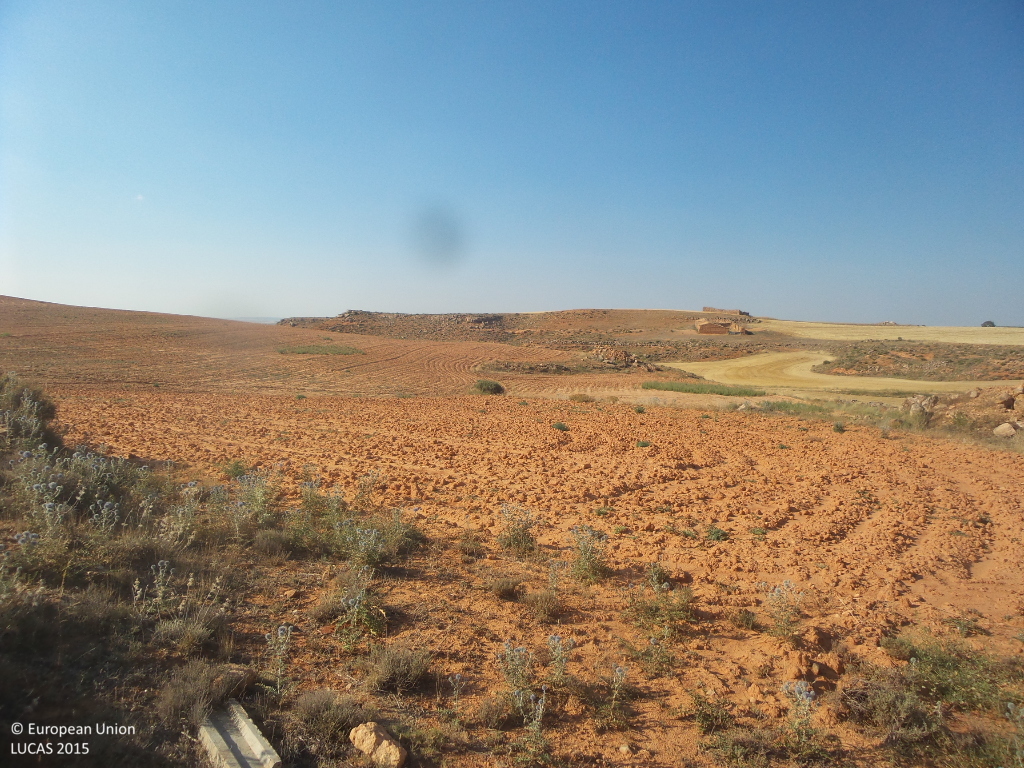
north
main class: Shrubland
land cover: Shrubland without tree cover
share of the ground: 50 - 75 %
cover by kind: shrubs 50 %, unconsolidated bare surface 40 %, herbaceous plants 10 %
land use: Semi-natural and natural areas not in use
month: July
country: ES
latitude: 41.2485
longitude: -2.1173
